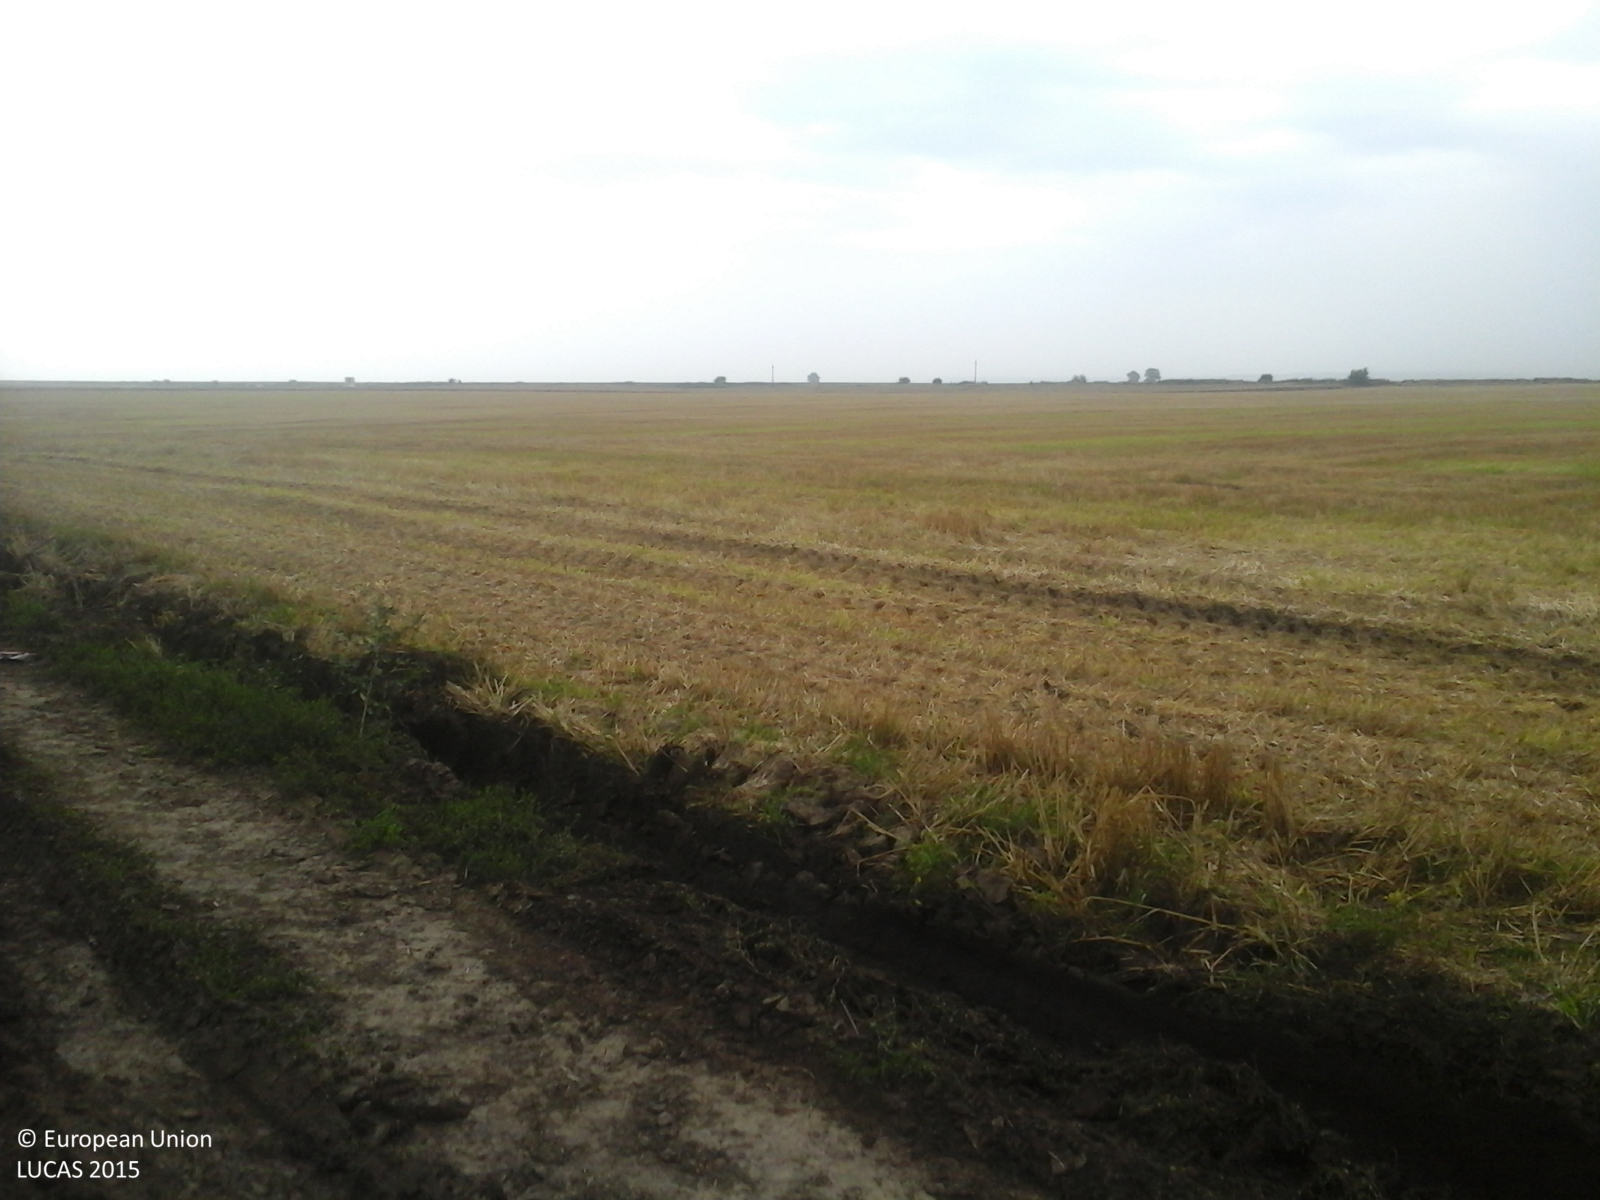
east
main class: Cropland
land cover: Maize
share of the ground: > 75 %
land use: Agriculture (excluding fallow land and kitchen gardens)
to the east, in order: Maize; Common wheat
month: July
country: RO
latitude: 43.7734
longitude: 25.6802
